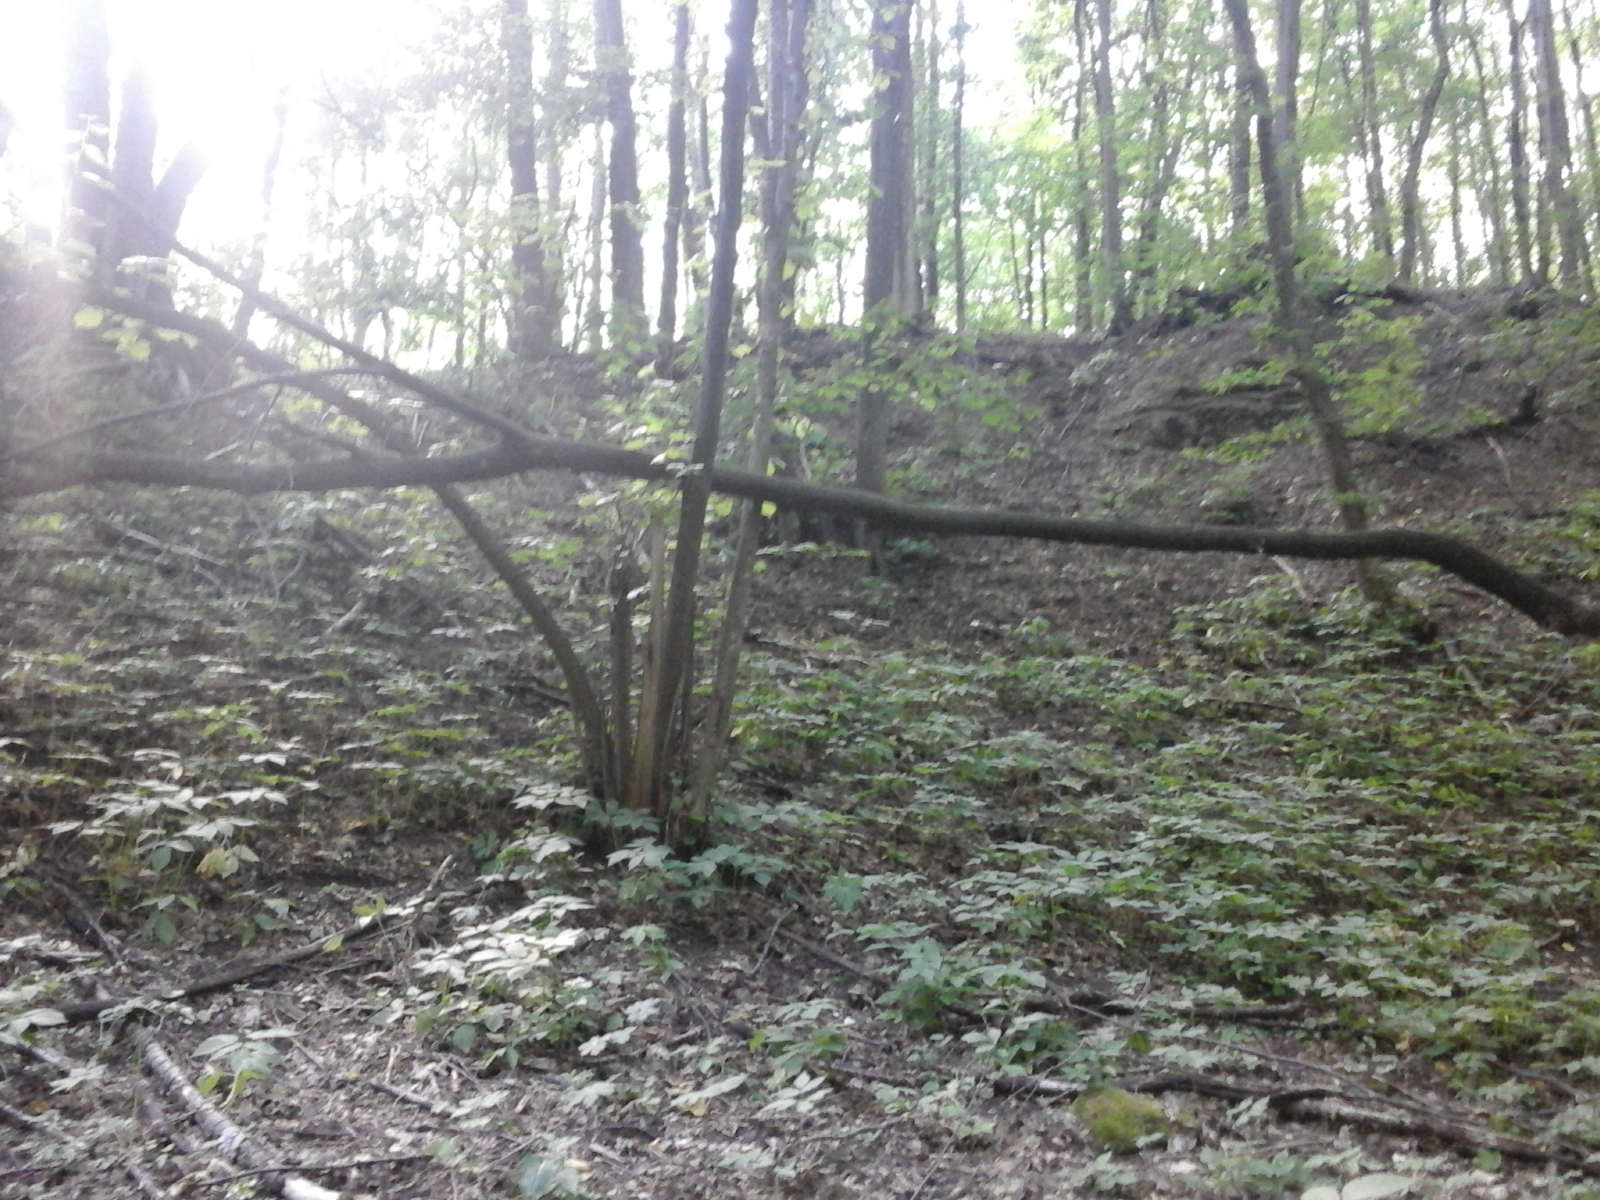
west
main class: Woodland
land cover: Broadleaved woodland
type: mesophytic deciduous forest
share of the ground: > 75 %
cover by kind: broadleaved forest trees 100 %
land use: Forestry
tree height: > 5 m
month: June
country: RO
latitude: 46.9959
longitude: 27.5940
